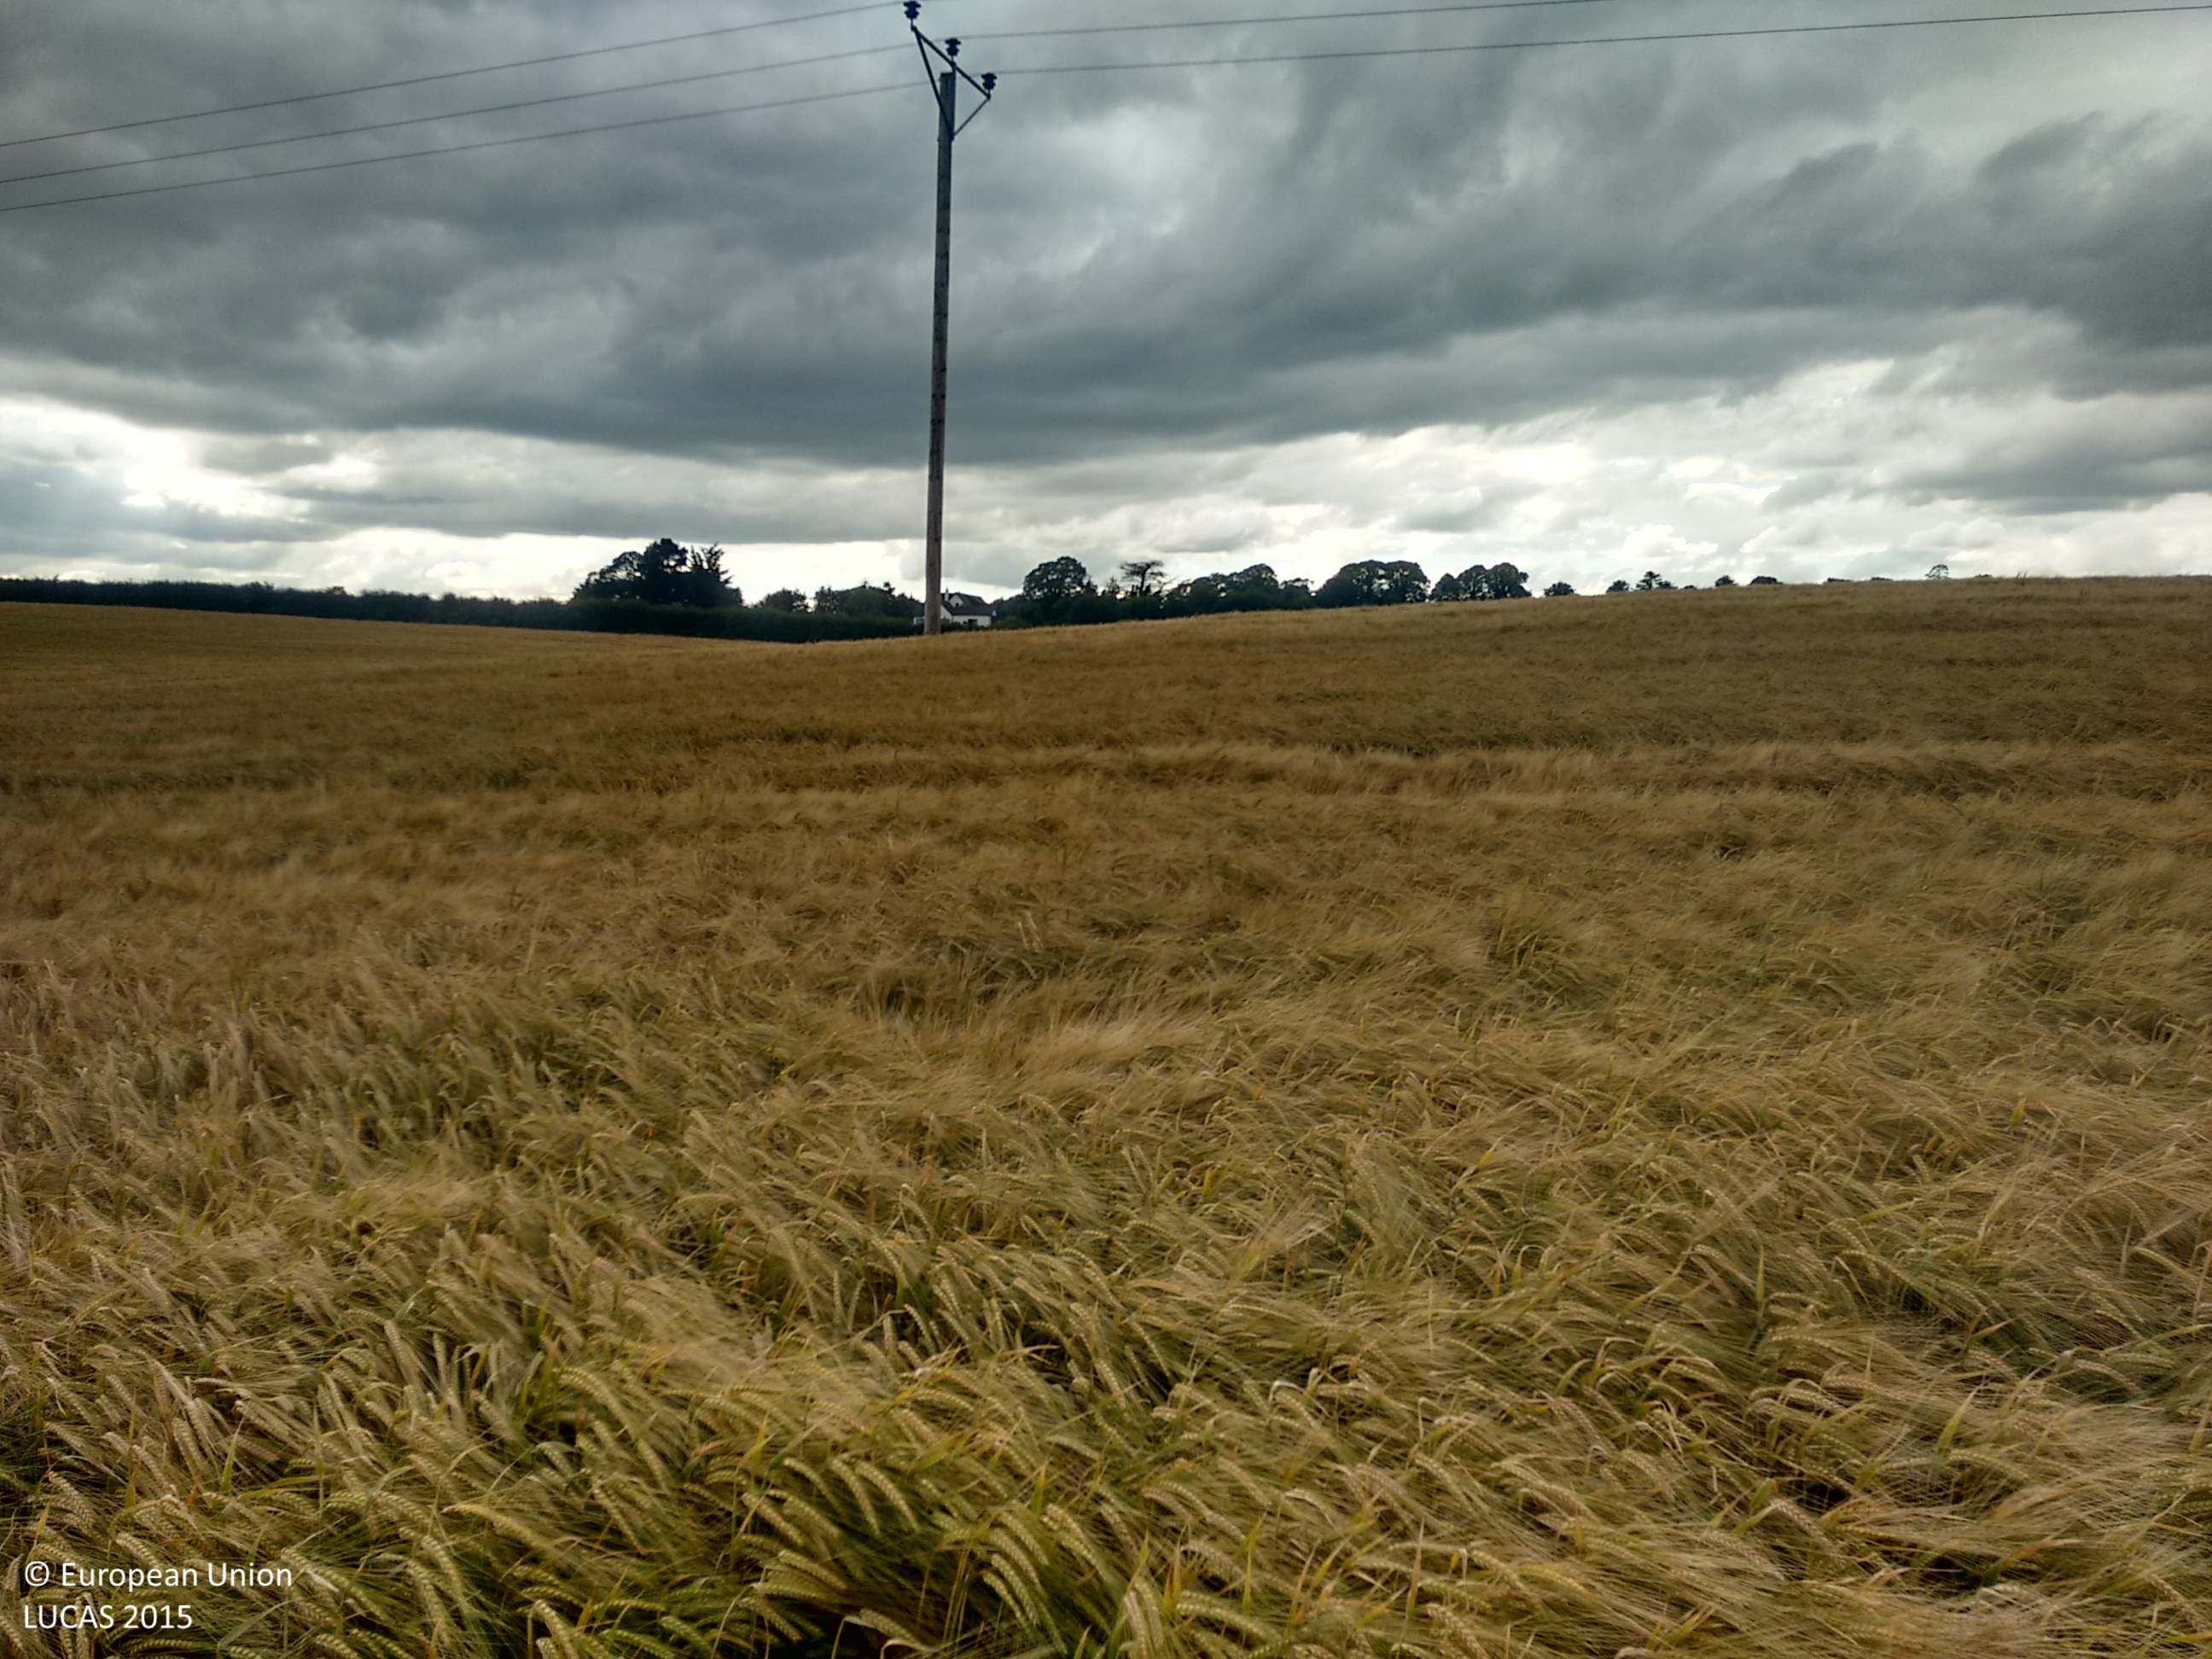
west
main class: Cropland
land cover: Barley
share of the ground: > 75 %
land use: Agriculture (excluding fallow land and kitchen gardens)
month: August
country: IE
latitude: 53.9354
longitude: -6.4688
